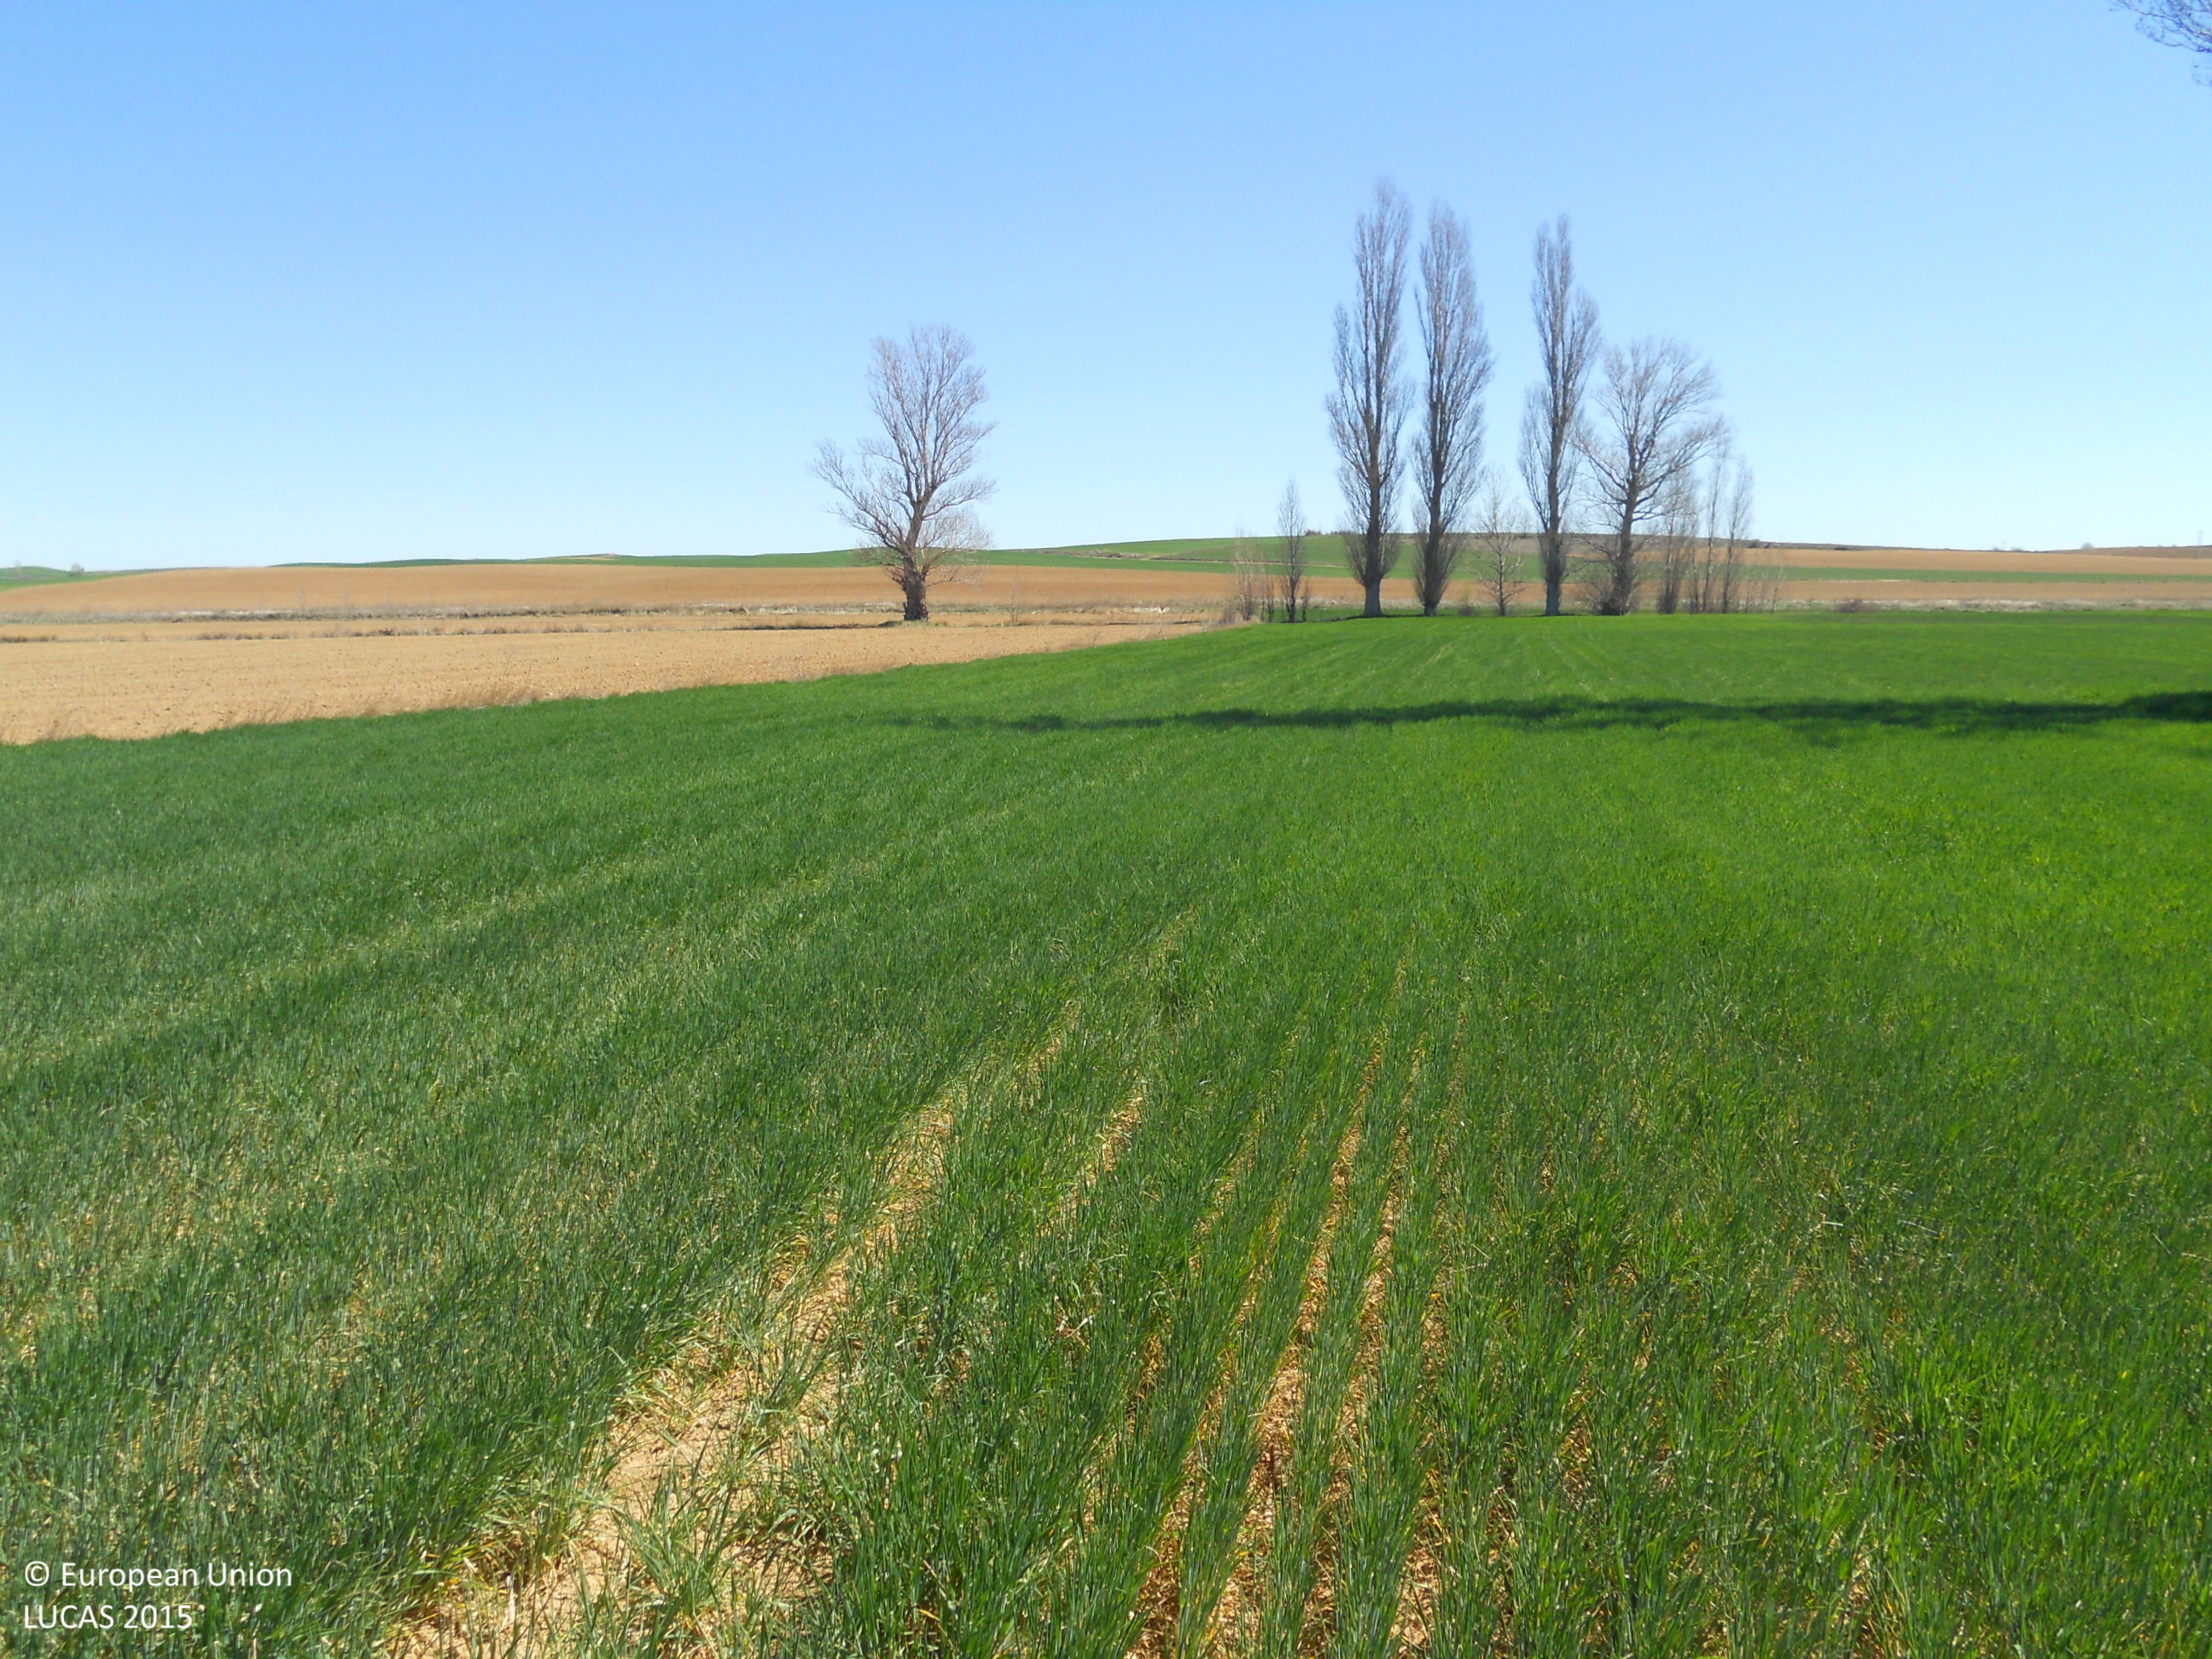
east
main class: Cropland
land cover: Barley
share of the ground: > 75 %
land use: Agriculture (excluding fallow land and kitchen gardens)
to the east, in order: Barley; Grass margins; Other bare soil; Groves; Grass margins; Other bare soil; Grassland without tree/shrub cover; Rivers and streams; Grassland without tree/shrub cover; Other bare soil
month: April
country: ES
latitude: 42.2308
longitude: -4.8487
